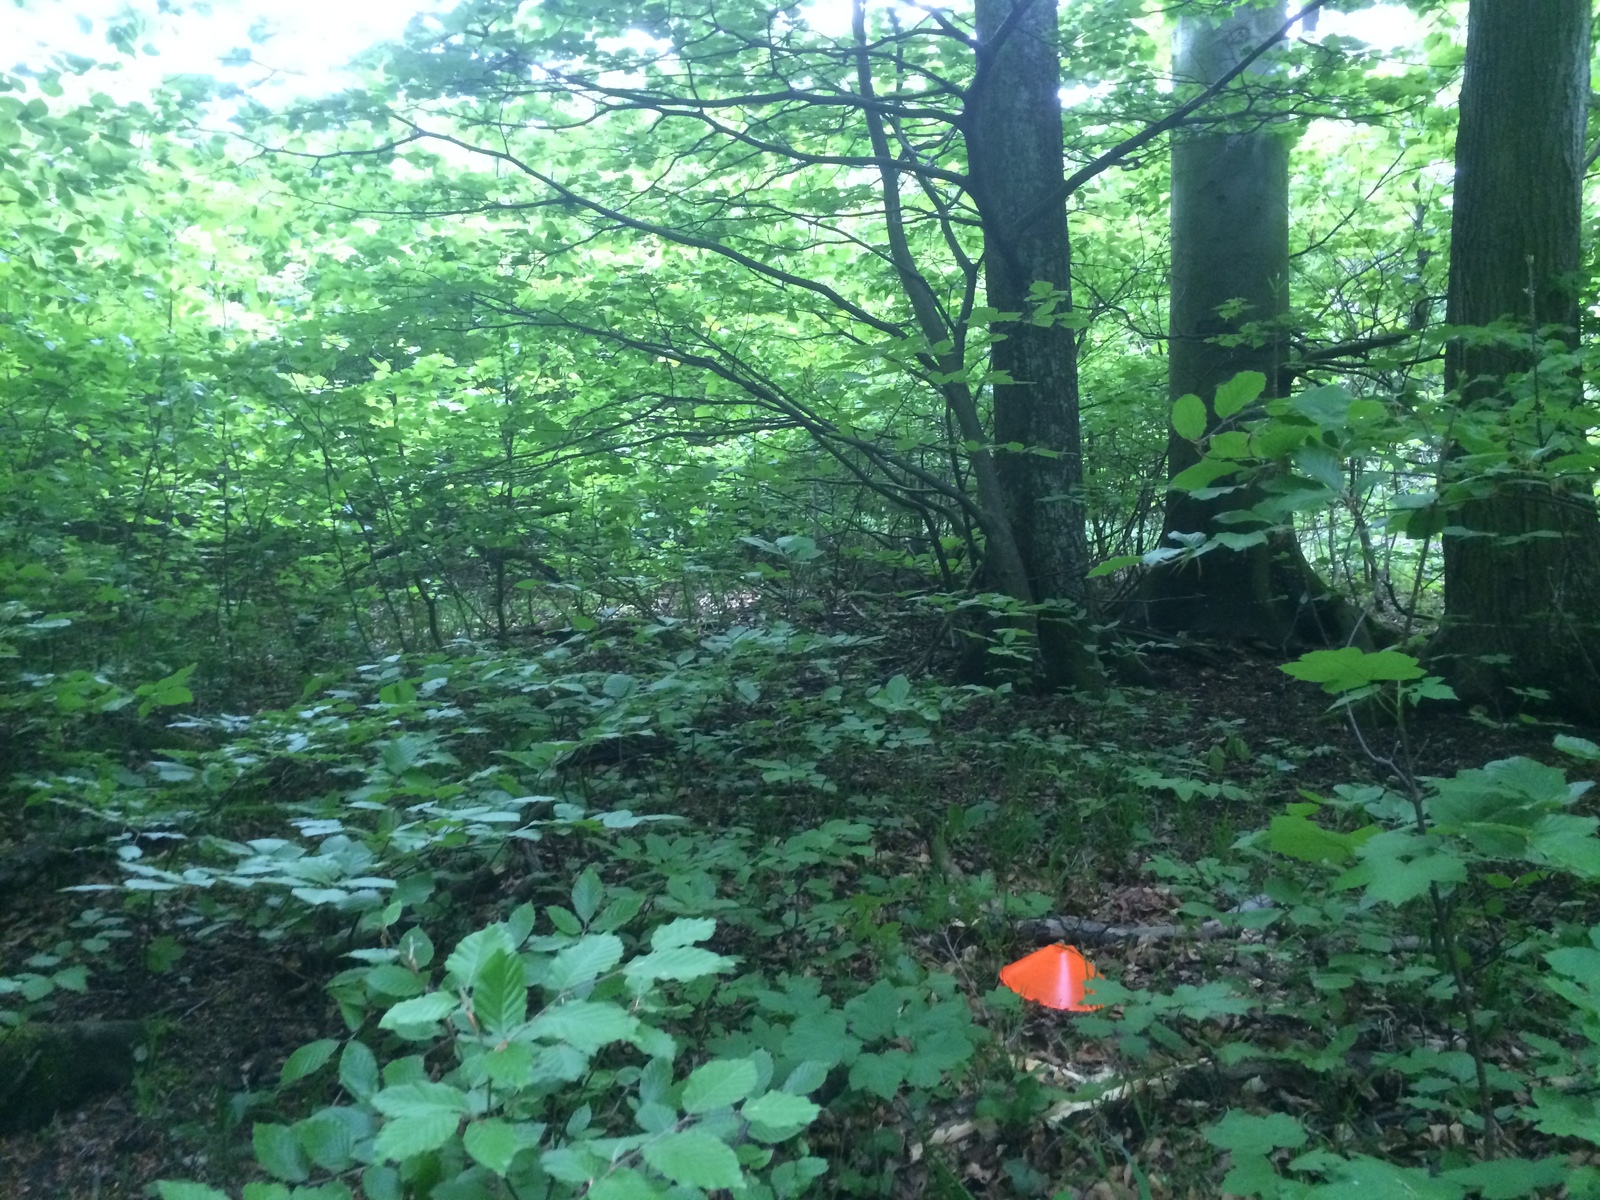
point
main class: Woodland
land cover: Broadleaved woodland
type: beech forest
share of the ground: > 75 %
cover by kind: broadleaved forest trees 100 %
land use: Forestry
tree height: > 5 m
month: May
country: AT
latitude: 48.0302
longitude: 16.2131
